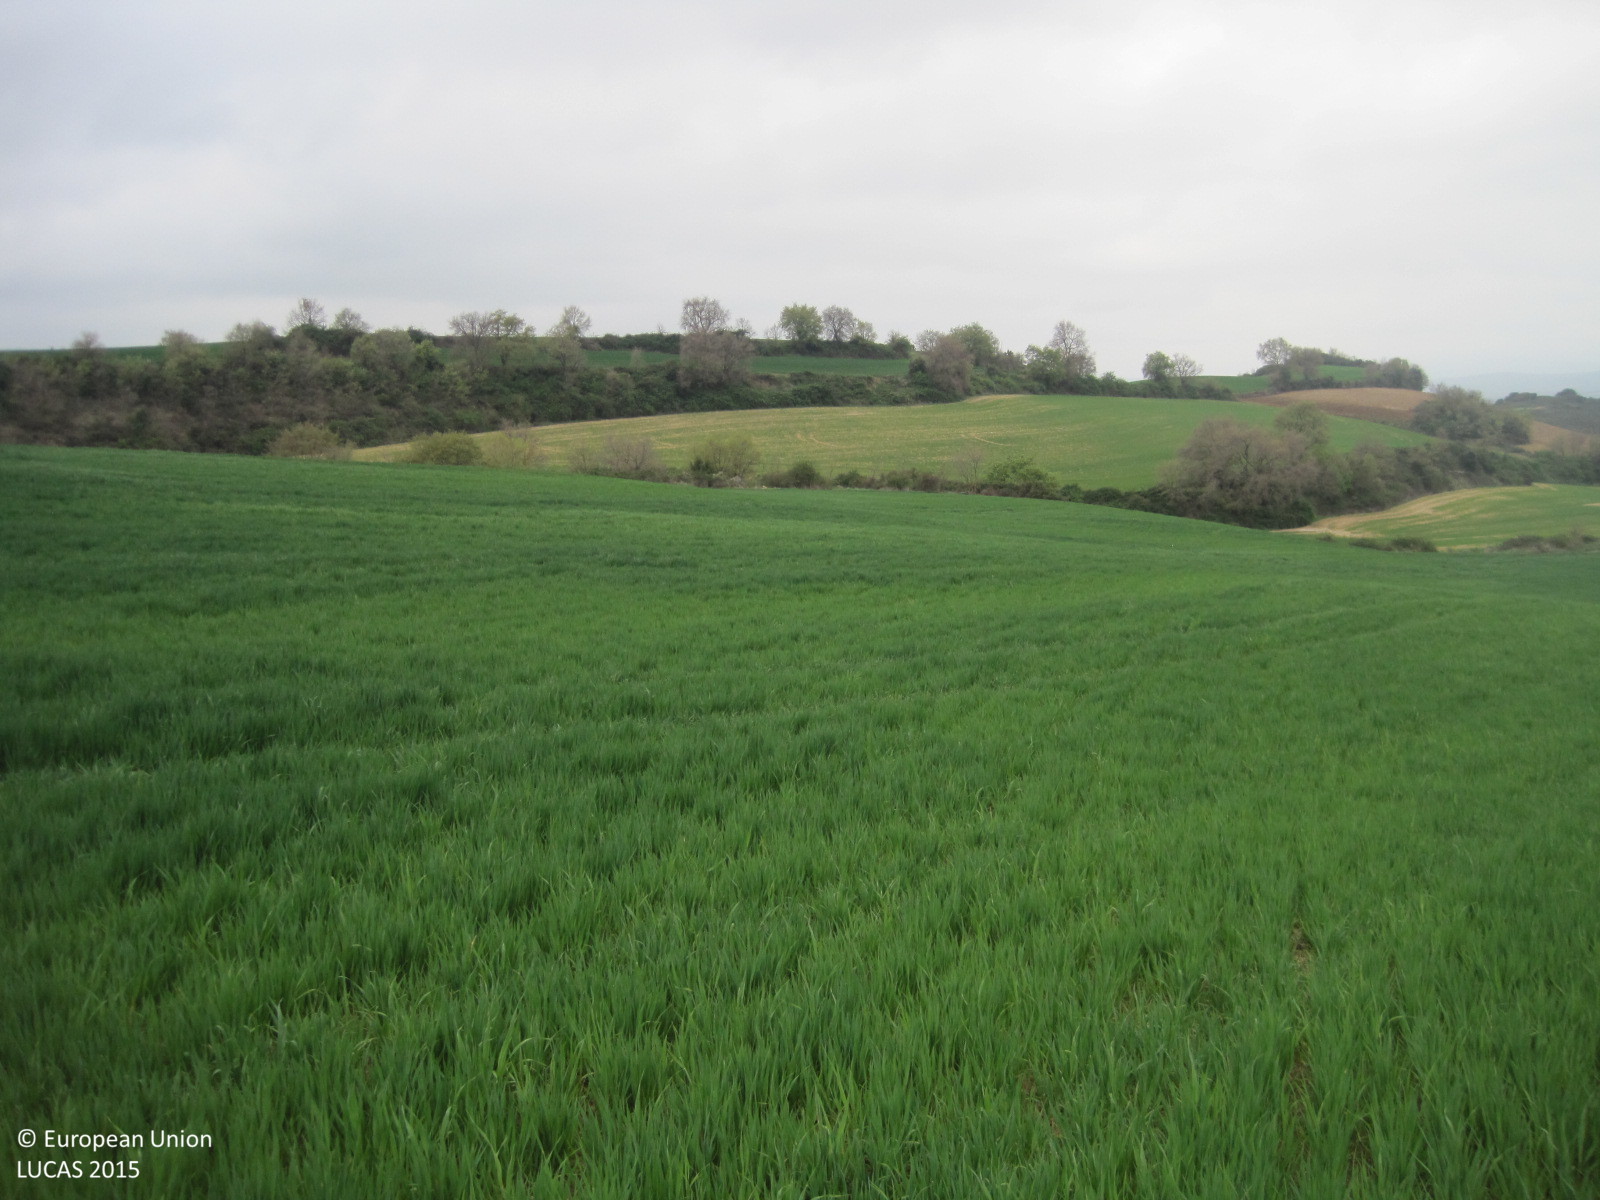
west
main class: Cropland
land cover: Rye
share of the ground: > 75 %
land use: Agriculture (excluding fallow land and kitchen gardens)
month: April
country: ES
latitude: 42.6338
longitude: -2.1275
